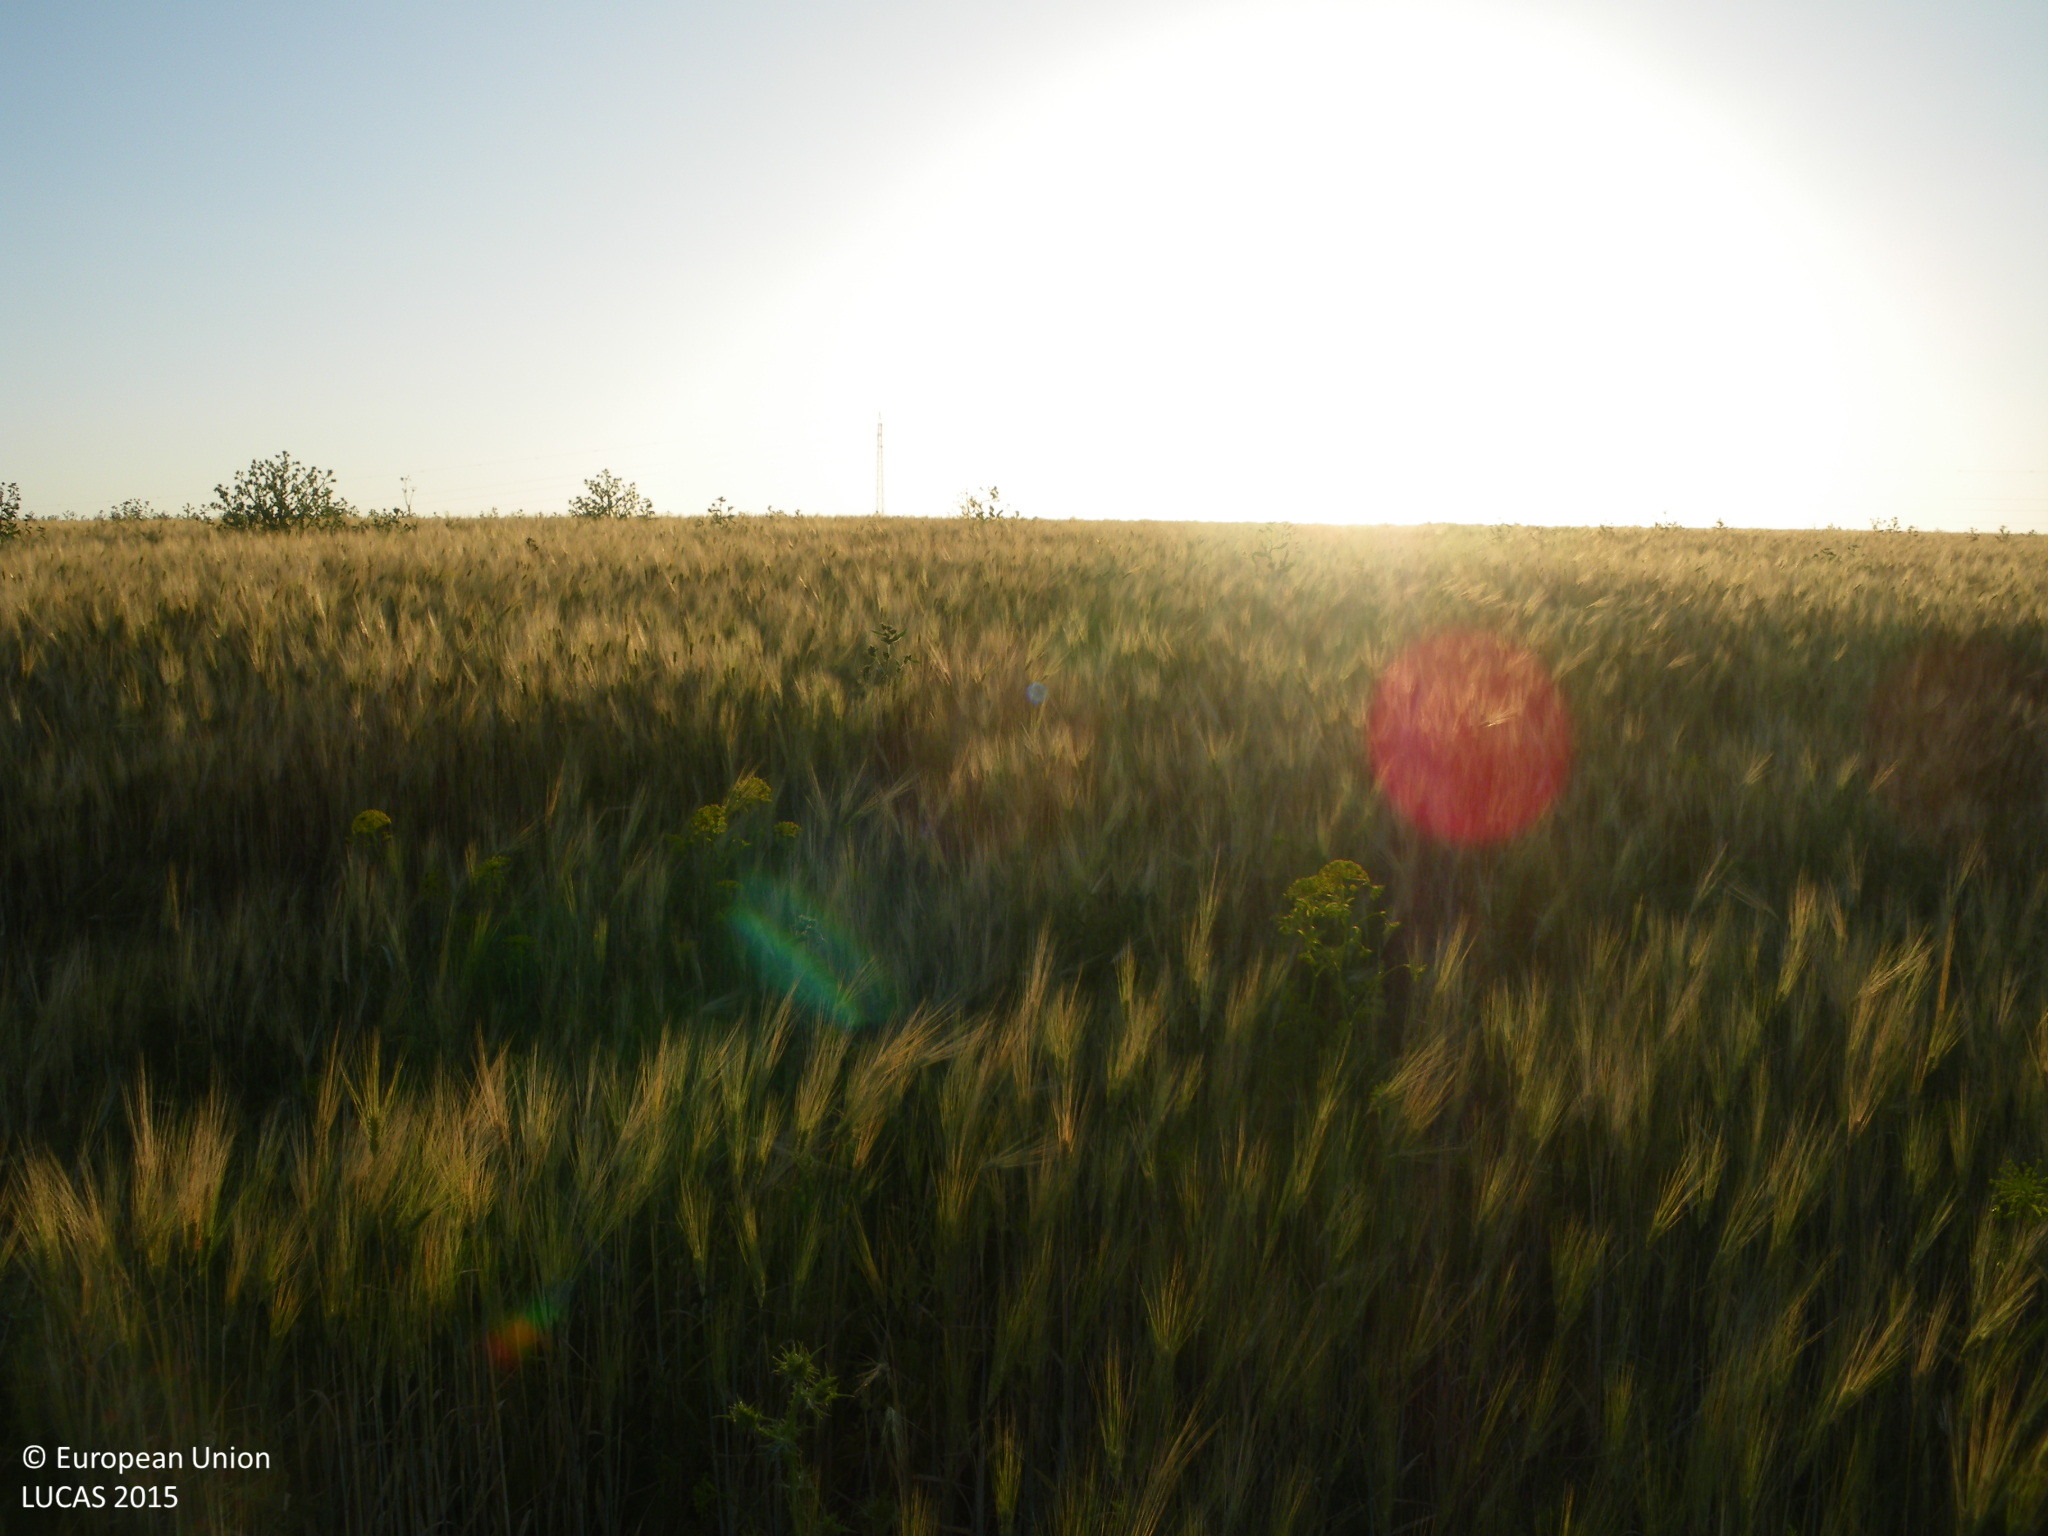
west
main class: Cropland
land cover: Other leguminous and mixtures for fodder
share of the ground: > 75 %
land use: Agriculture (excluding fallow land and kitchen gardens)
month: May
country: ES
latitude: 36.7467
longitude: -6.2440
